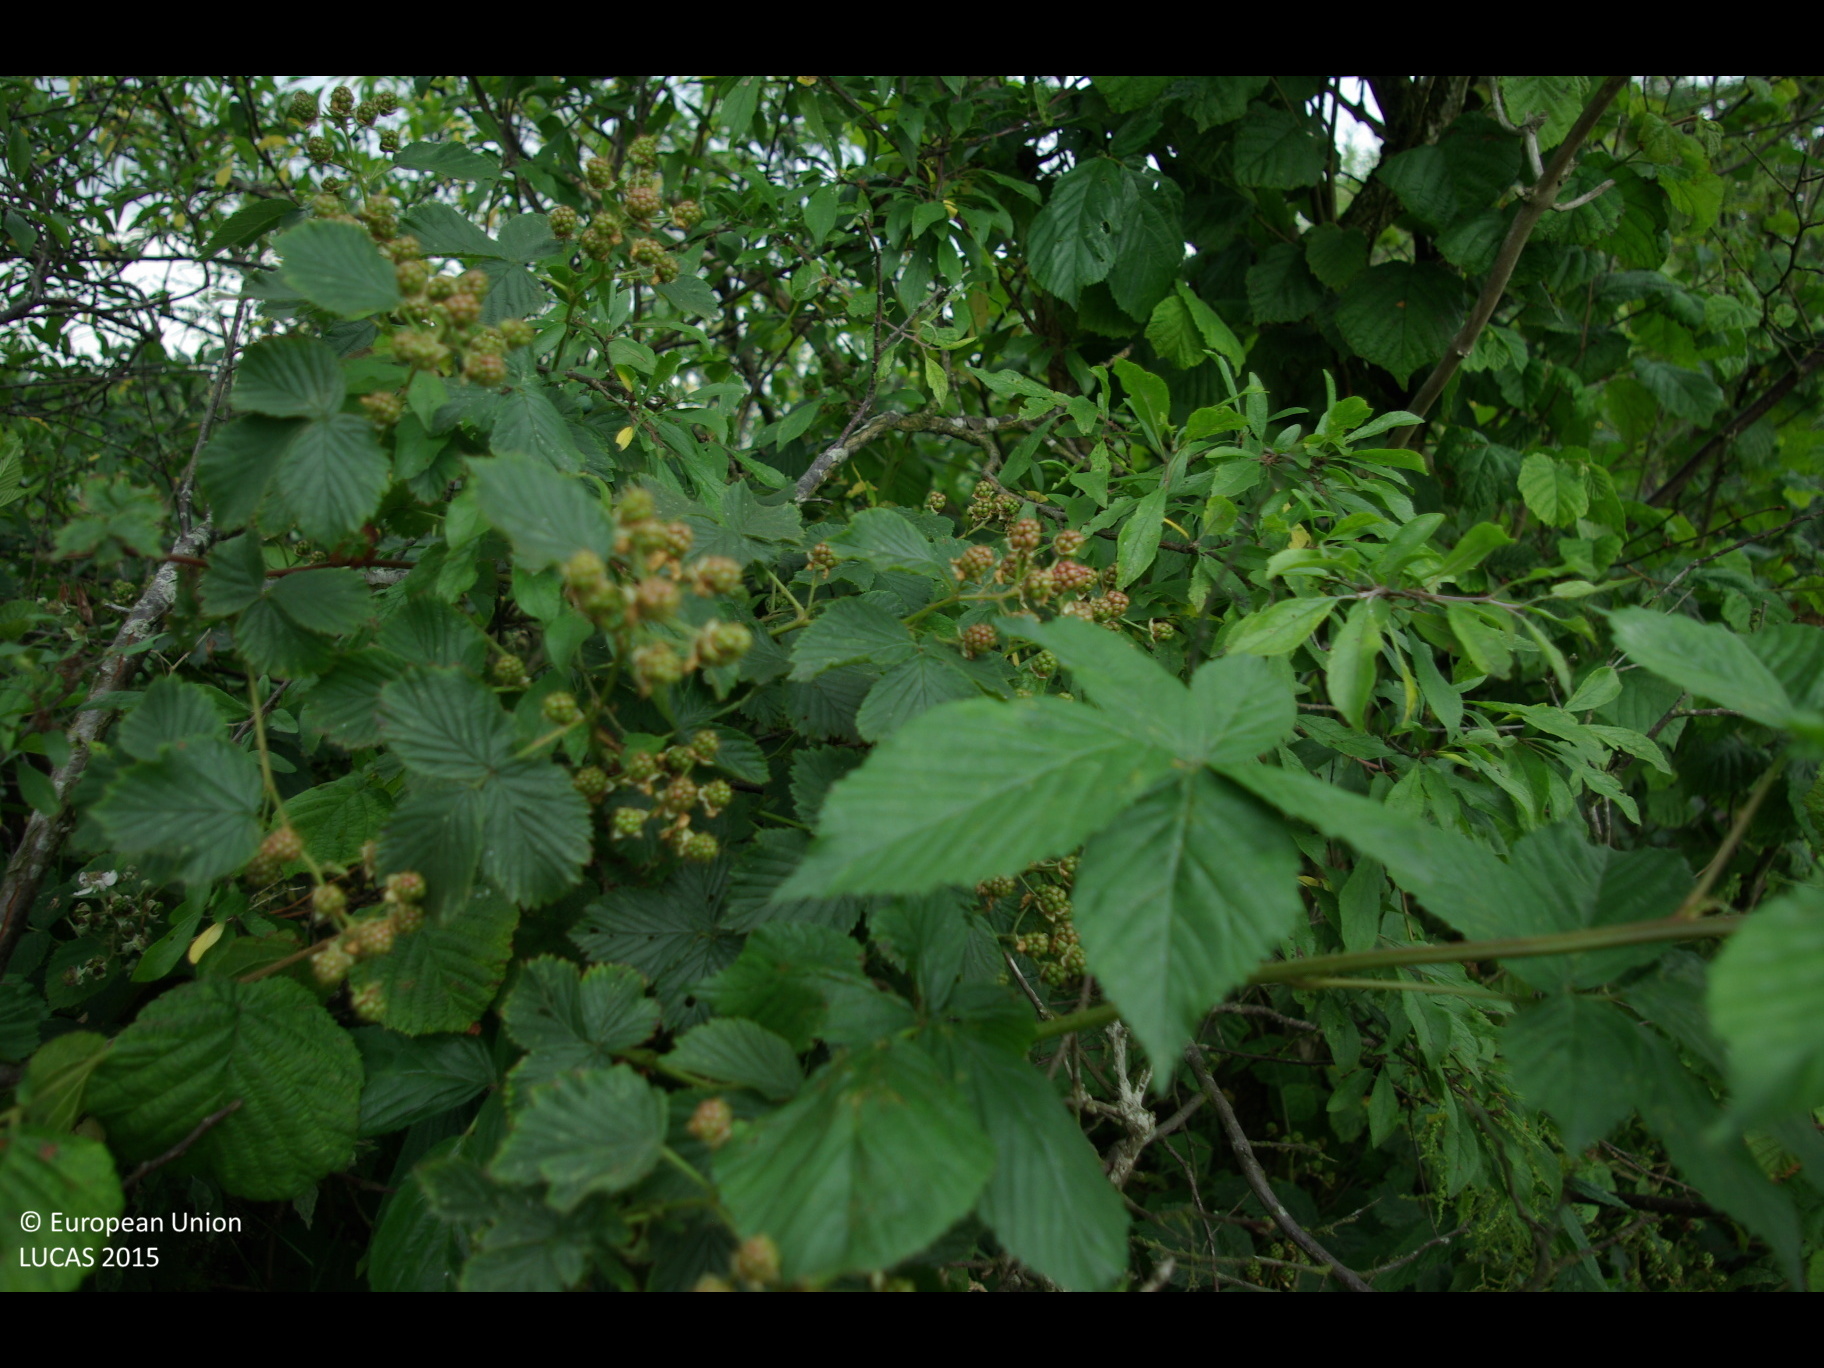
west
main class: Cropland
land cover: Maize
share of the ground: > 75 %
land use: Agriculture (excluding fallow land and kitchen gardens)
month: July
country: DE
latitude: 54.1728
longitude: 9.3111
